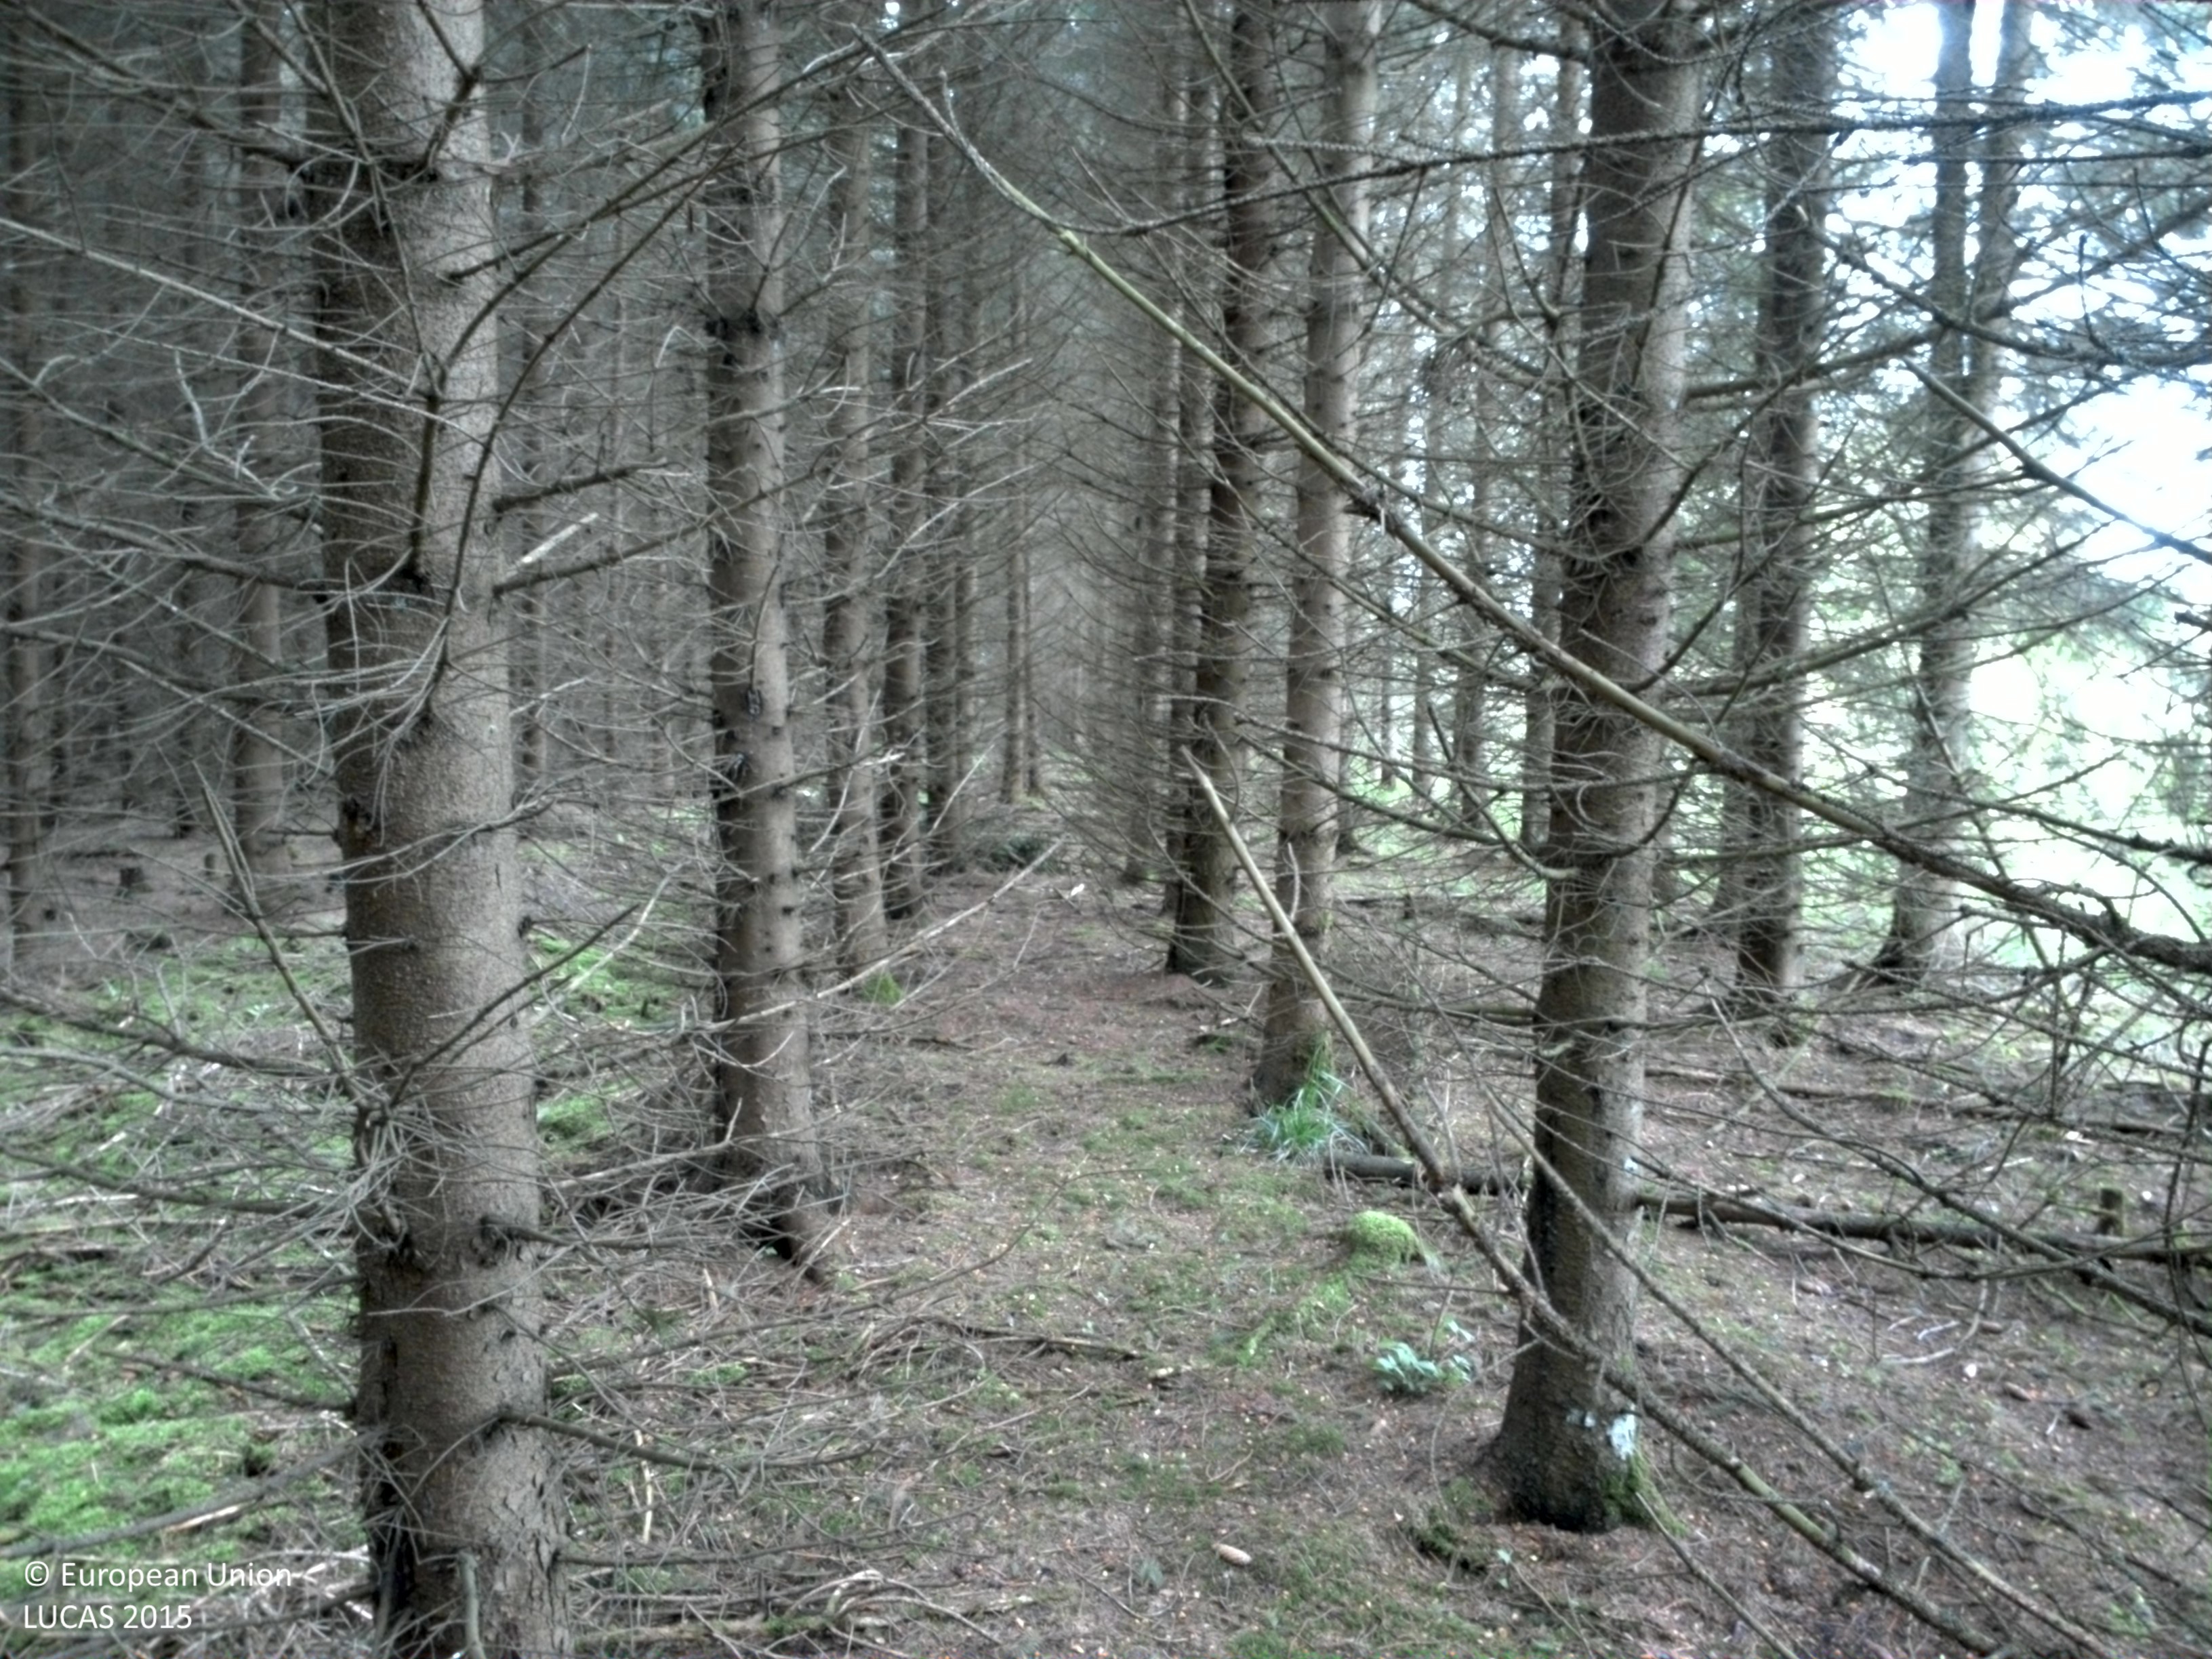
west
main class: Woodland
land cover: Spruce dominated coniferous woodland
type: boreal forest
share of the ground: > 75 %
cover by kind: coniferous forest trees 90 %, herbaceous plants 5 %, lichens and mosses 5 %
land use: Forestry
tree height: > 5 m
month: June
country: SE
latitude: 58.2531
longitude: 13.8962
